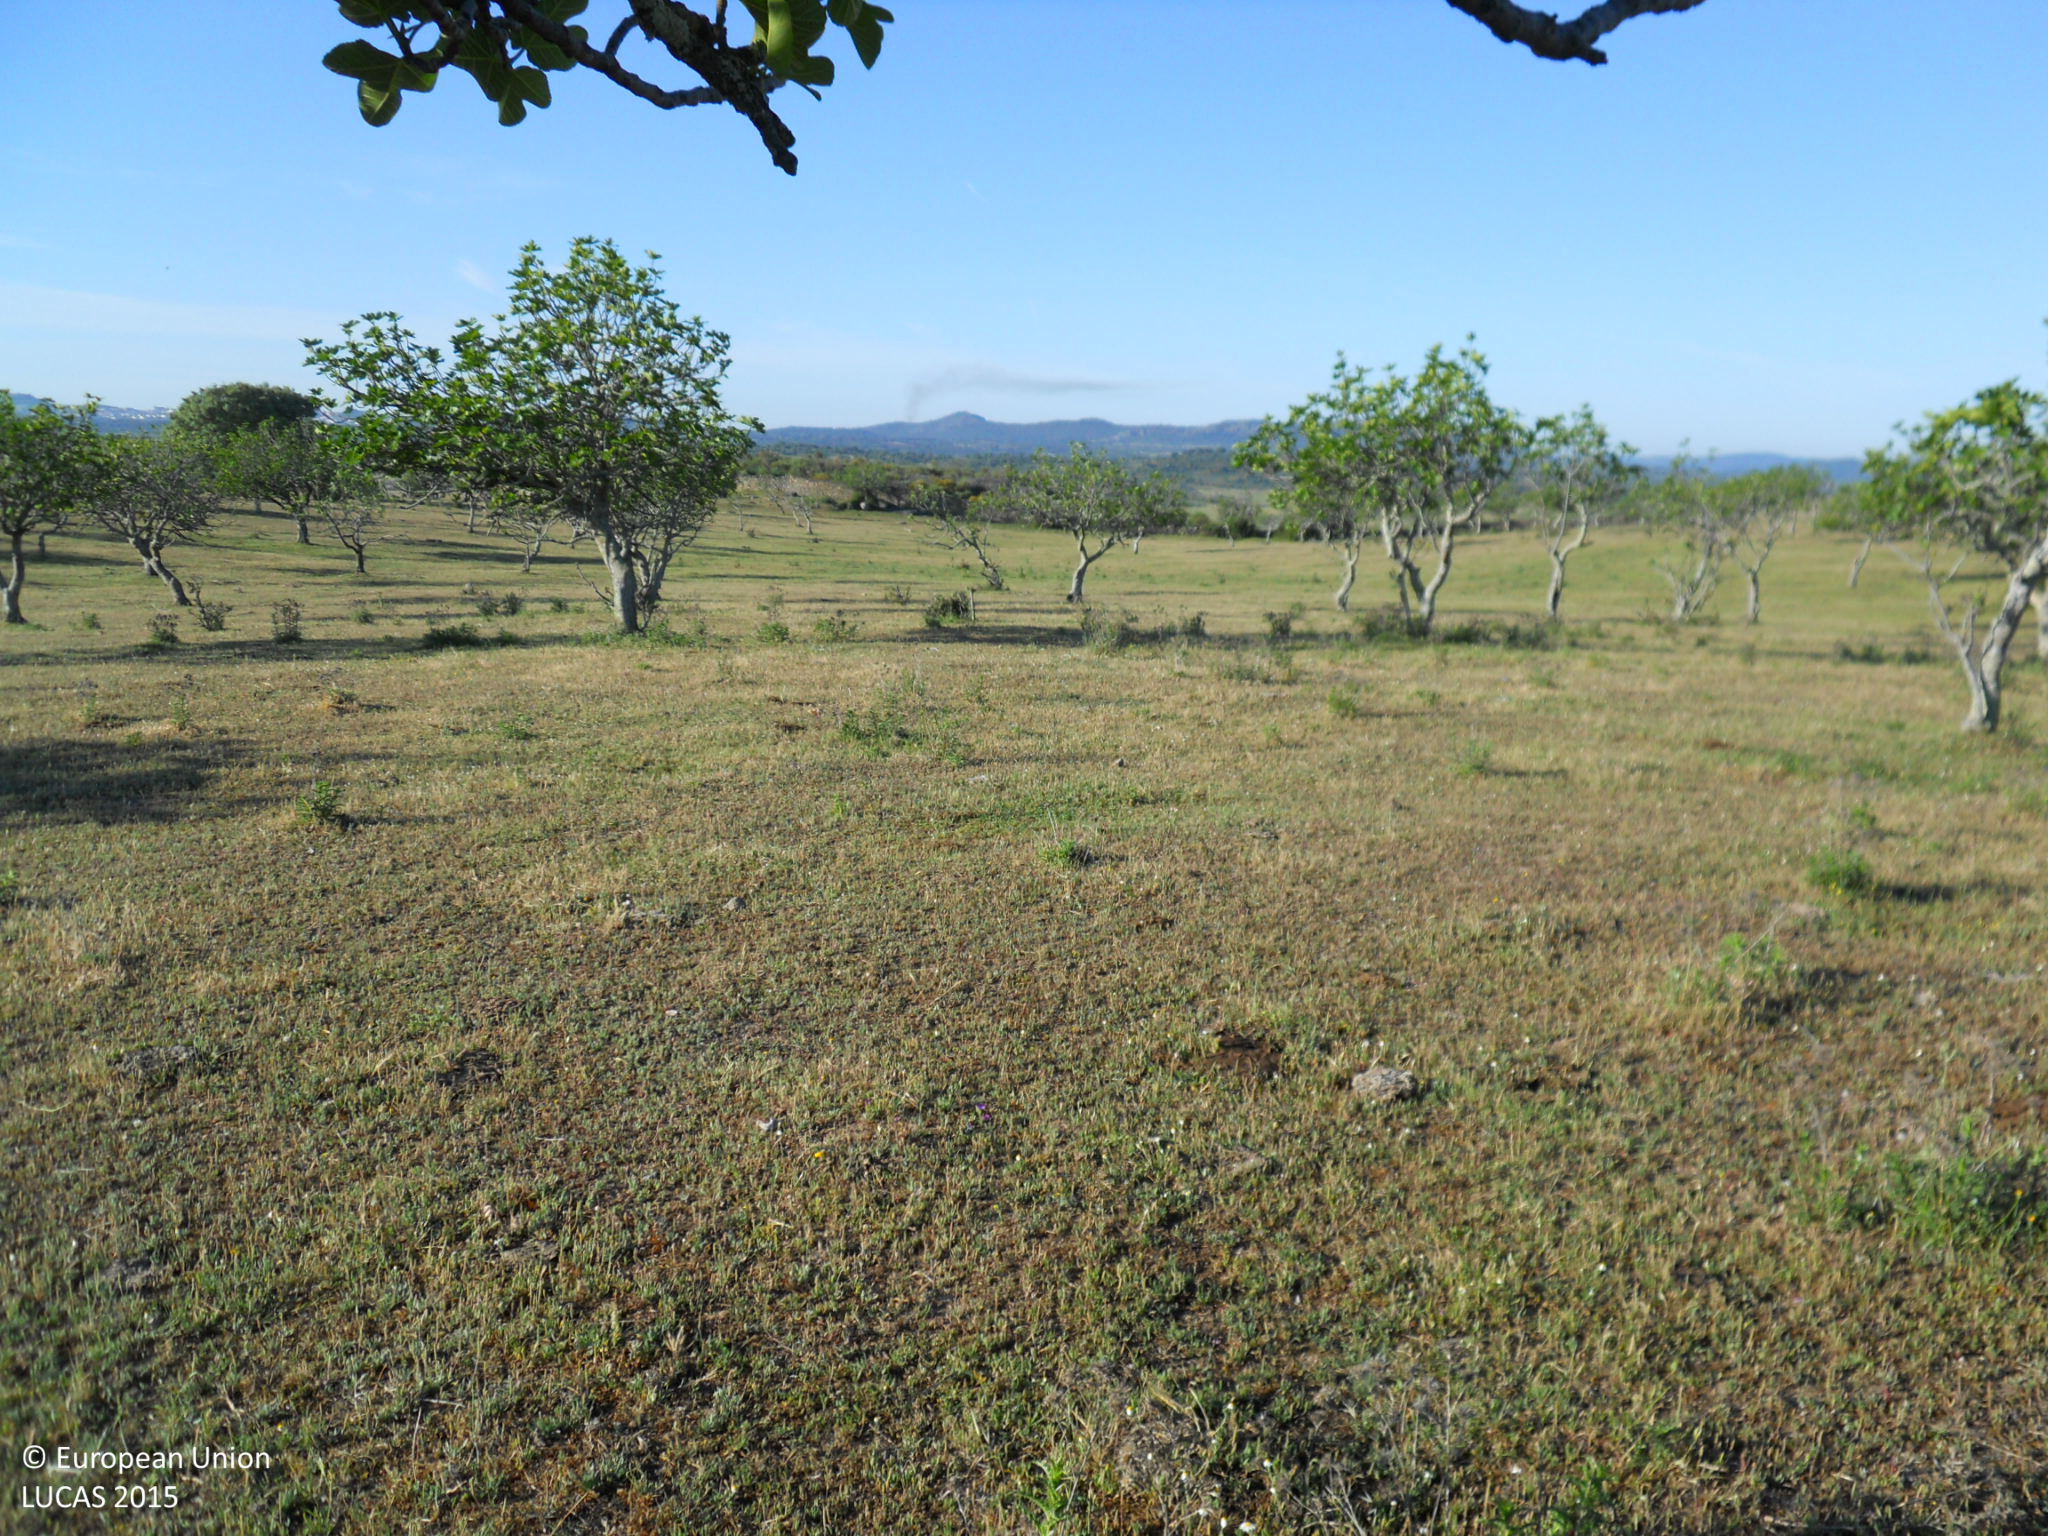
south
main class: Cropland
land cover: Other fruit trees and berries
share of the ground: 25 - 50 %
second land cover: Spontaneously vegetated surfaces
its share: > 75 %
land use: Agriculture (excluding fallow land and kitchen gardens)
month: April
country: ES
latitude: 39.2849
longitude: -7.0161
